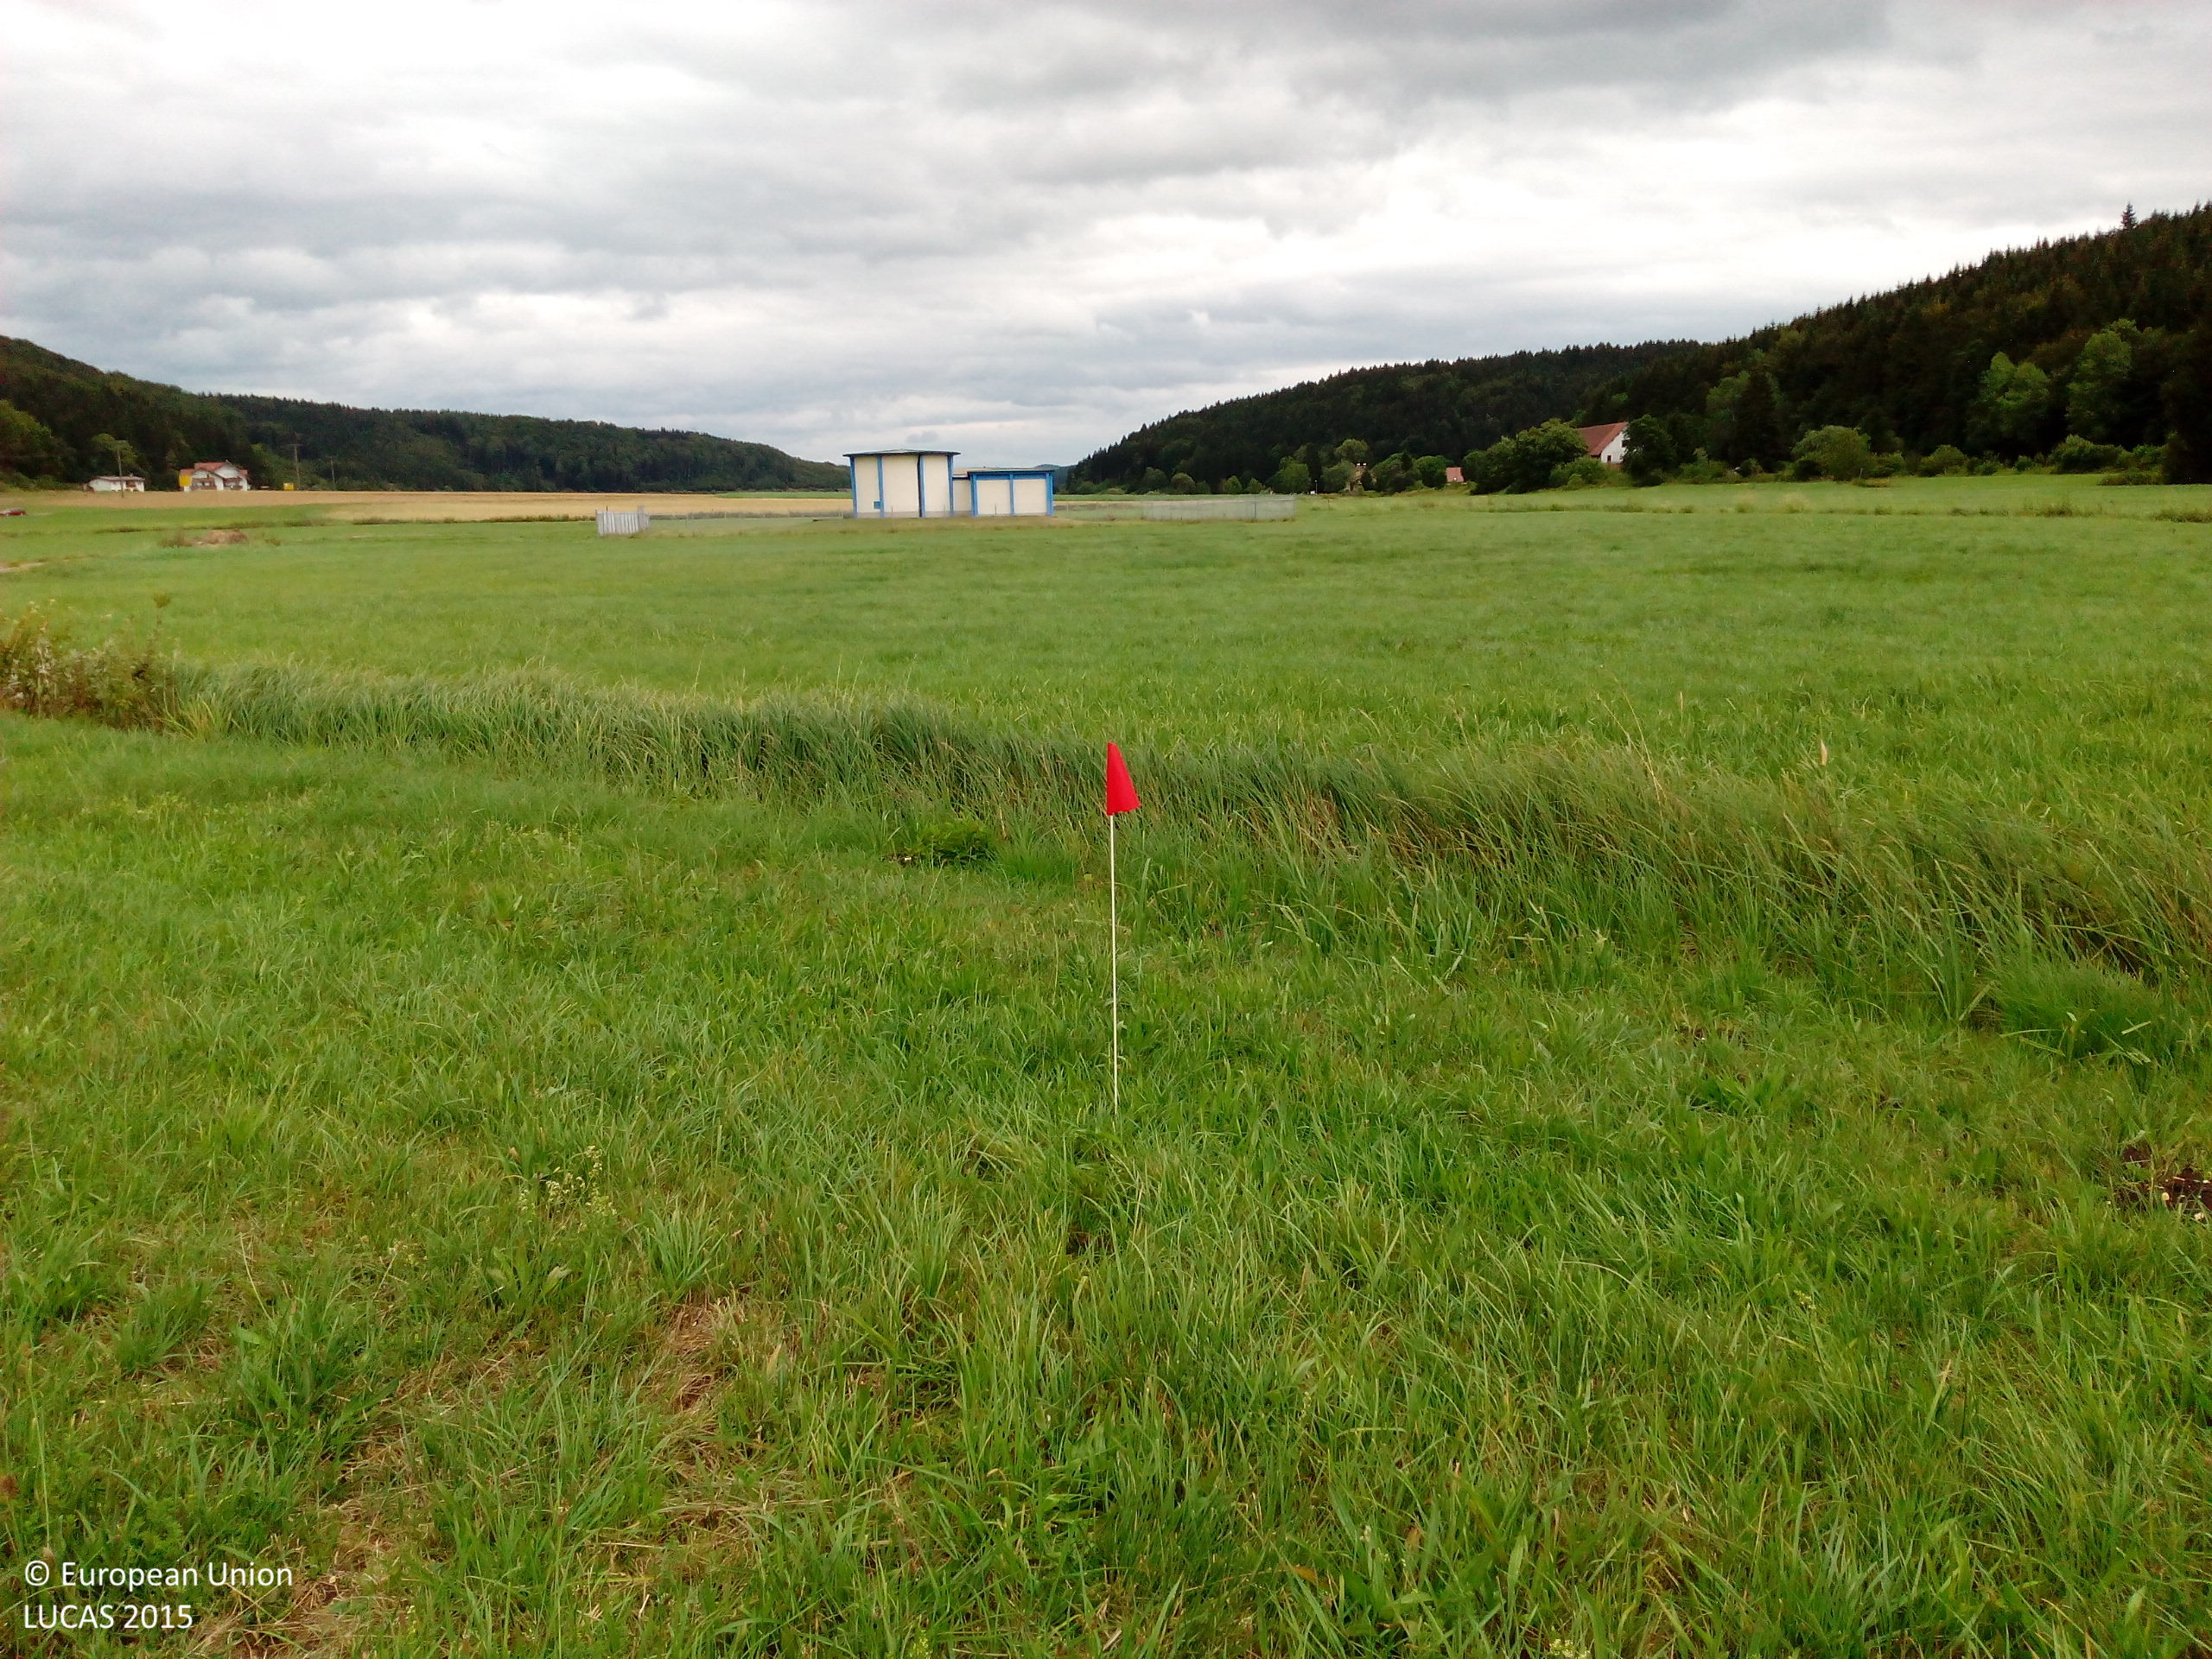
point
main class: Grassland
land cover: Grassland without tree/shrub cover
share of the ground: > 75 %
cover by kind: herbaceous plants 95 %, unconsolidated bare surface 5 %
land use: Agriculture (excluding fallow land and kitchen gardens)
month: July
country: DE
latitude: 47.8546
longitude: 8.5976
